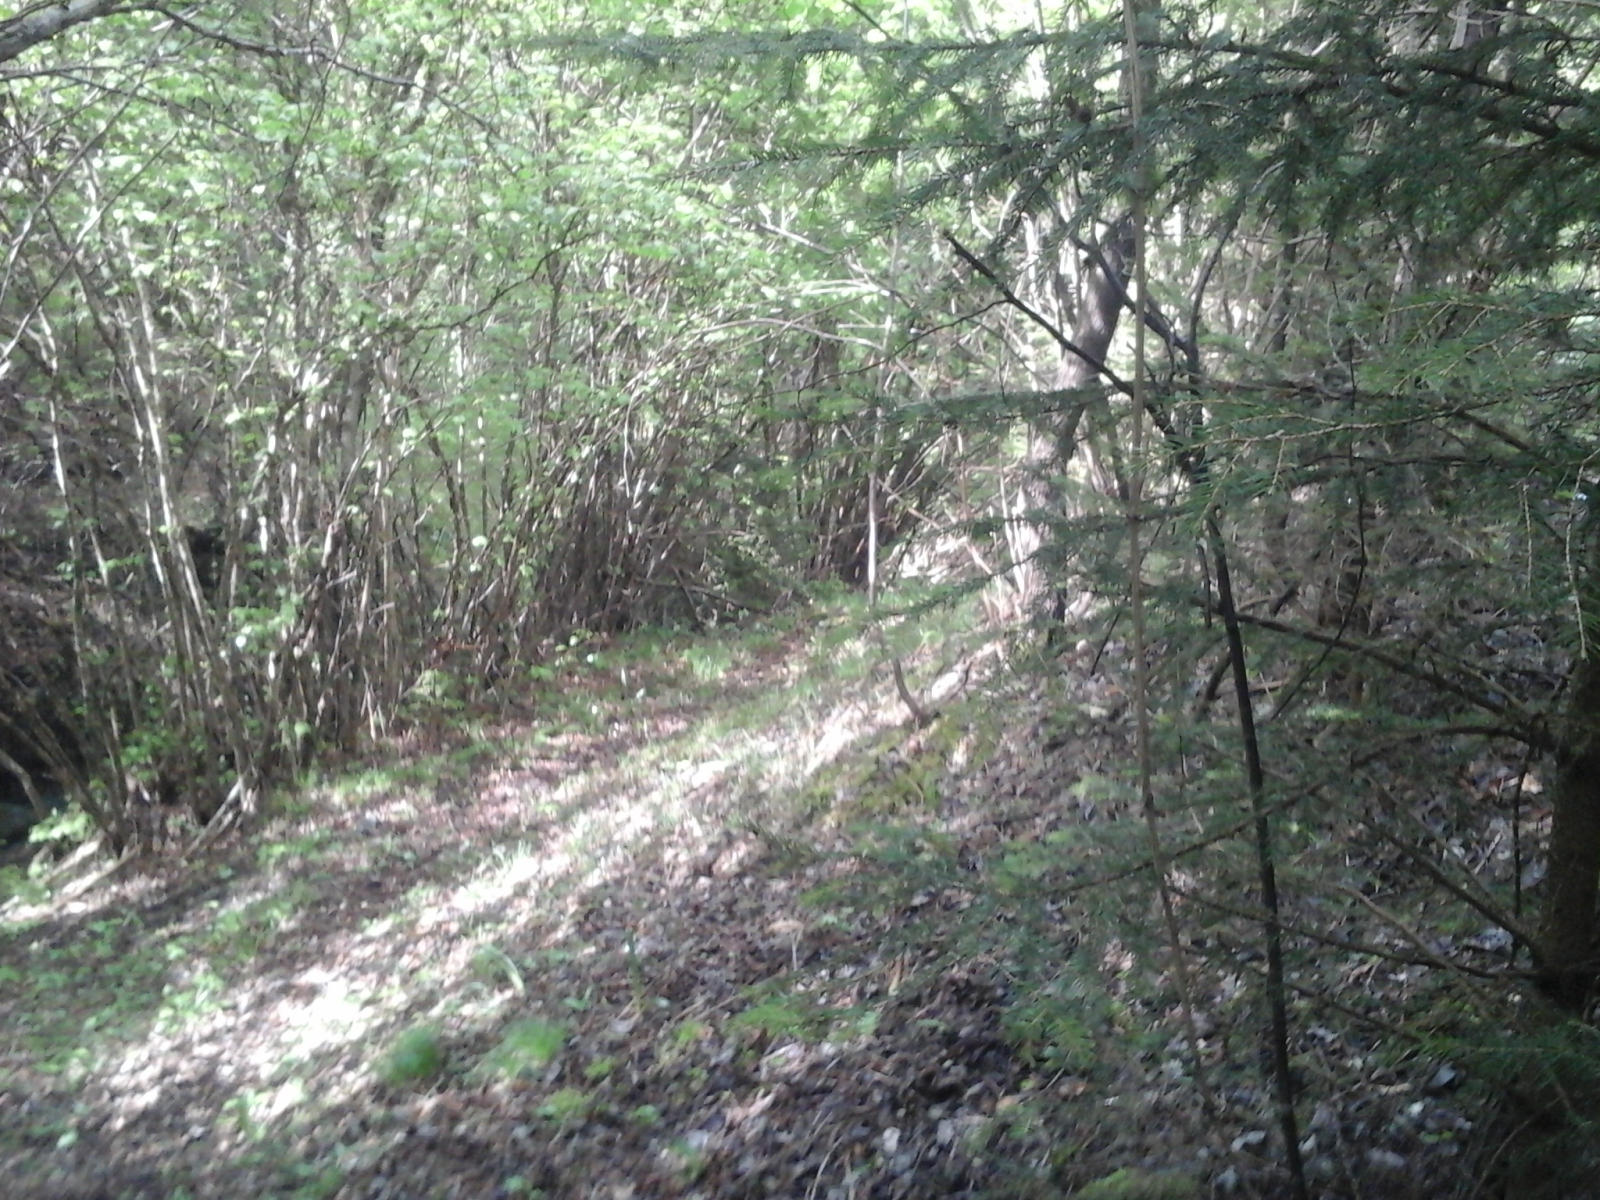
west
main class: Woodland
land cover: Broadleaved woodland
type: mesophytic deciduous forest
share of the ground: > 75 %
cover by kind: broadleaved forest trees 95 %, coniferous forest trees 5 %
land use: Forestry
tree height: > 5 m
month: May
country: IT
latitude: 45.9528
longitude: 10.6570
